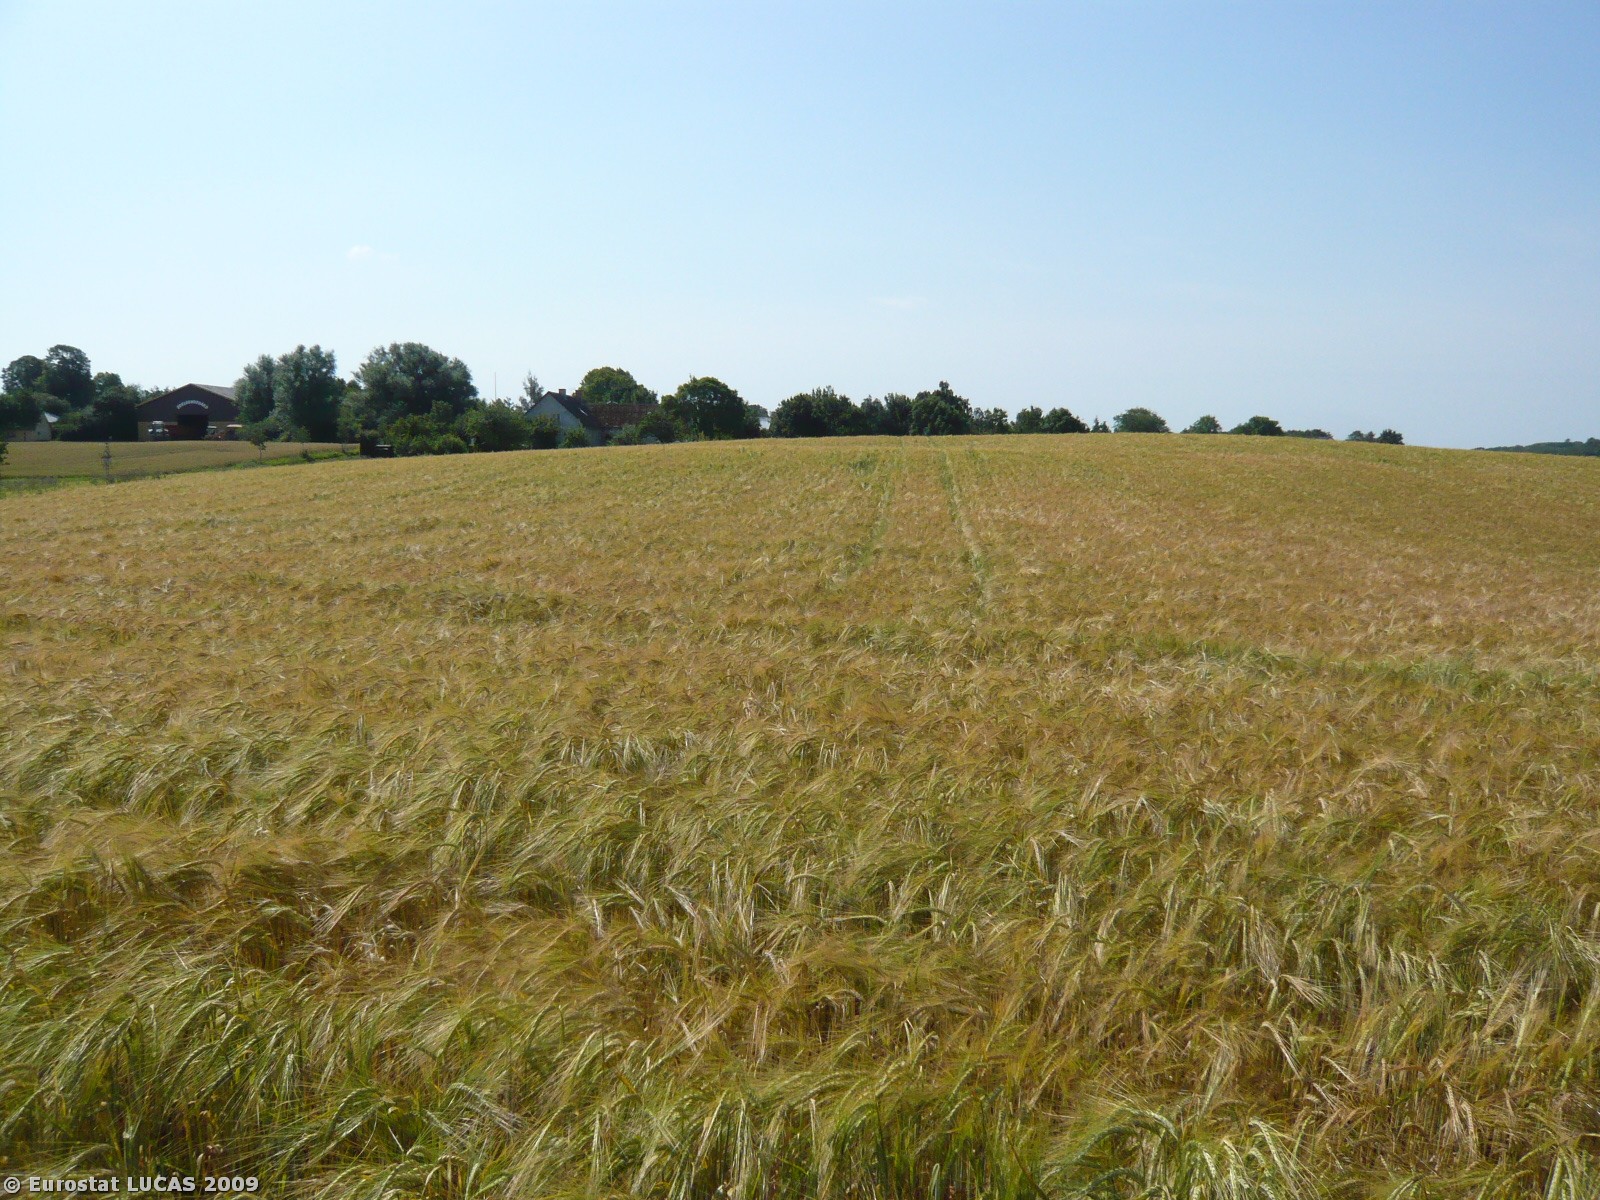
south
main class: Cropland
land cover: Barley
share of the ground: > 75 %
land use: Agriculture (excluding fallow land and kitchen gardens)
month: July
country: DK
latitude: 55.5815
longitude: 11.8227
